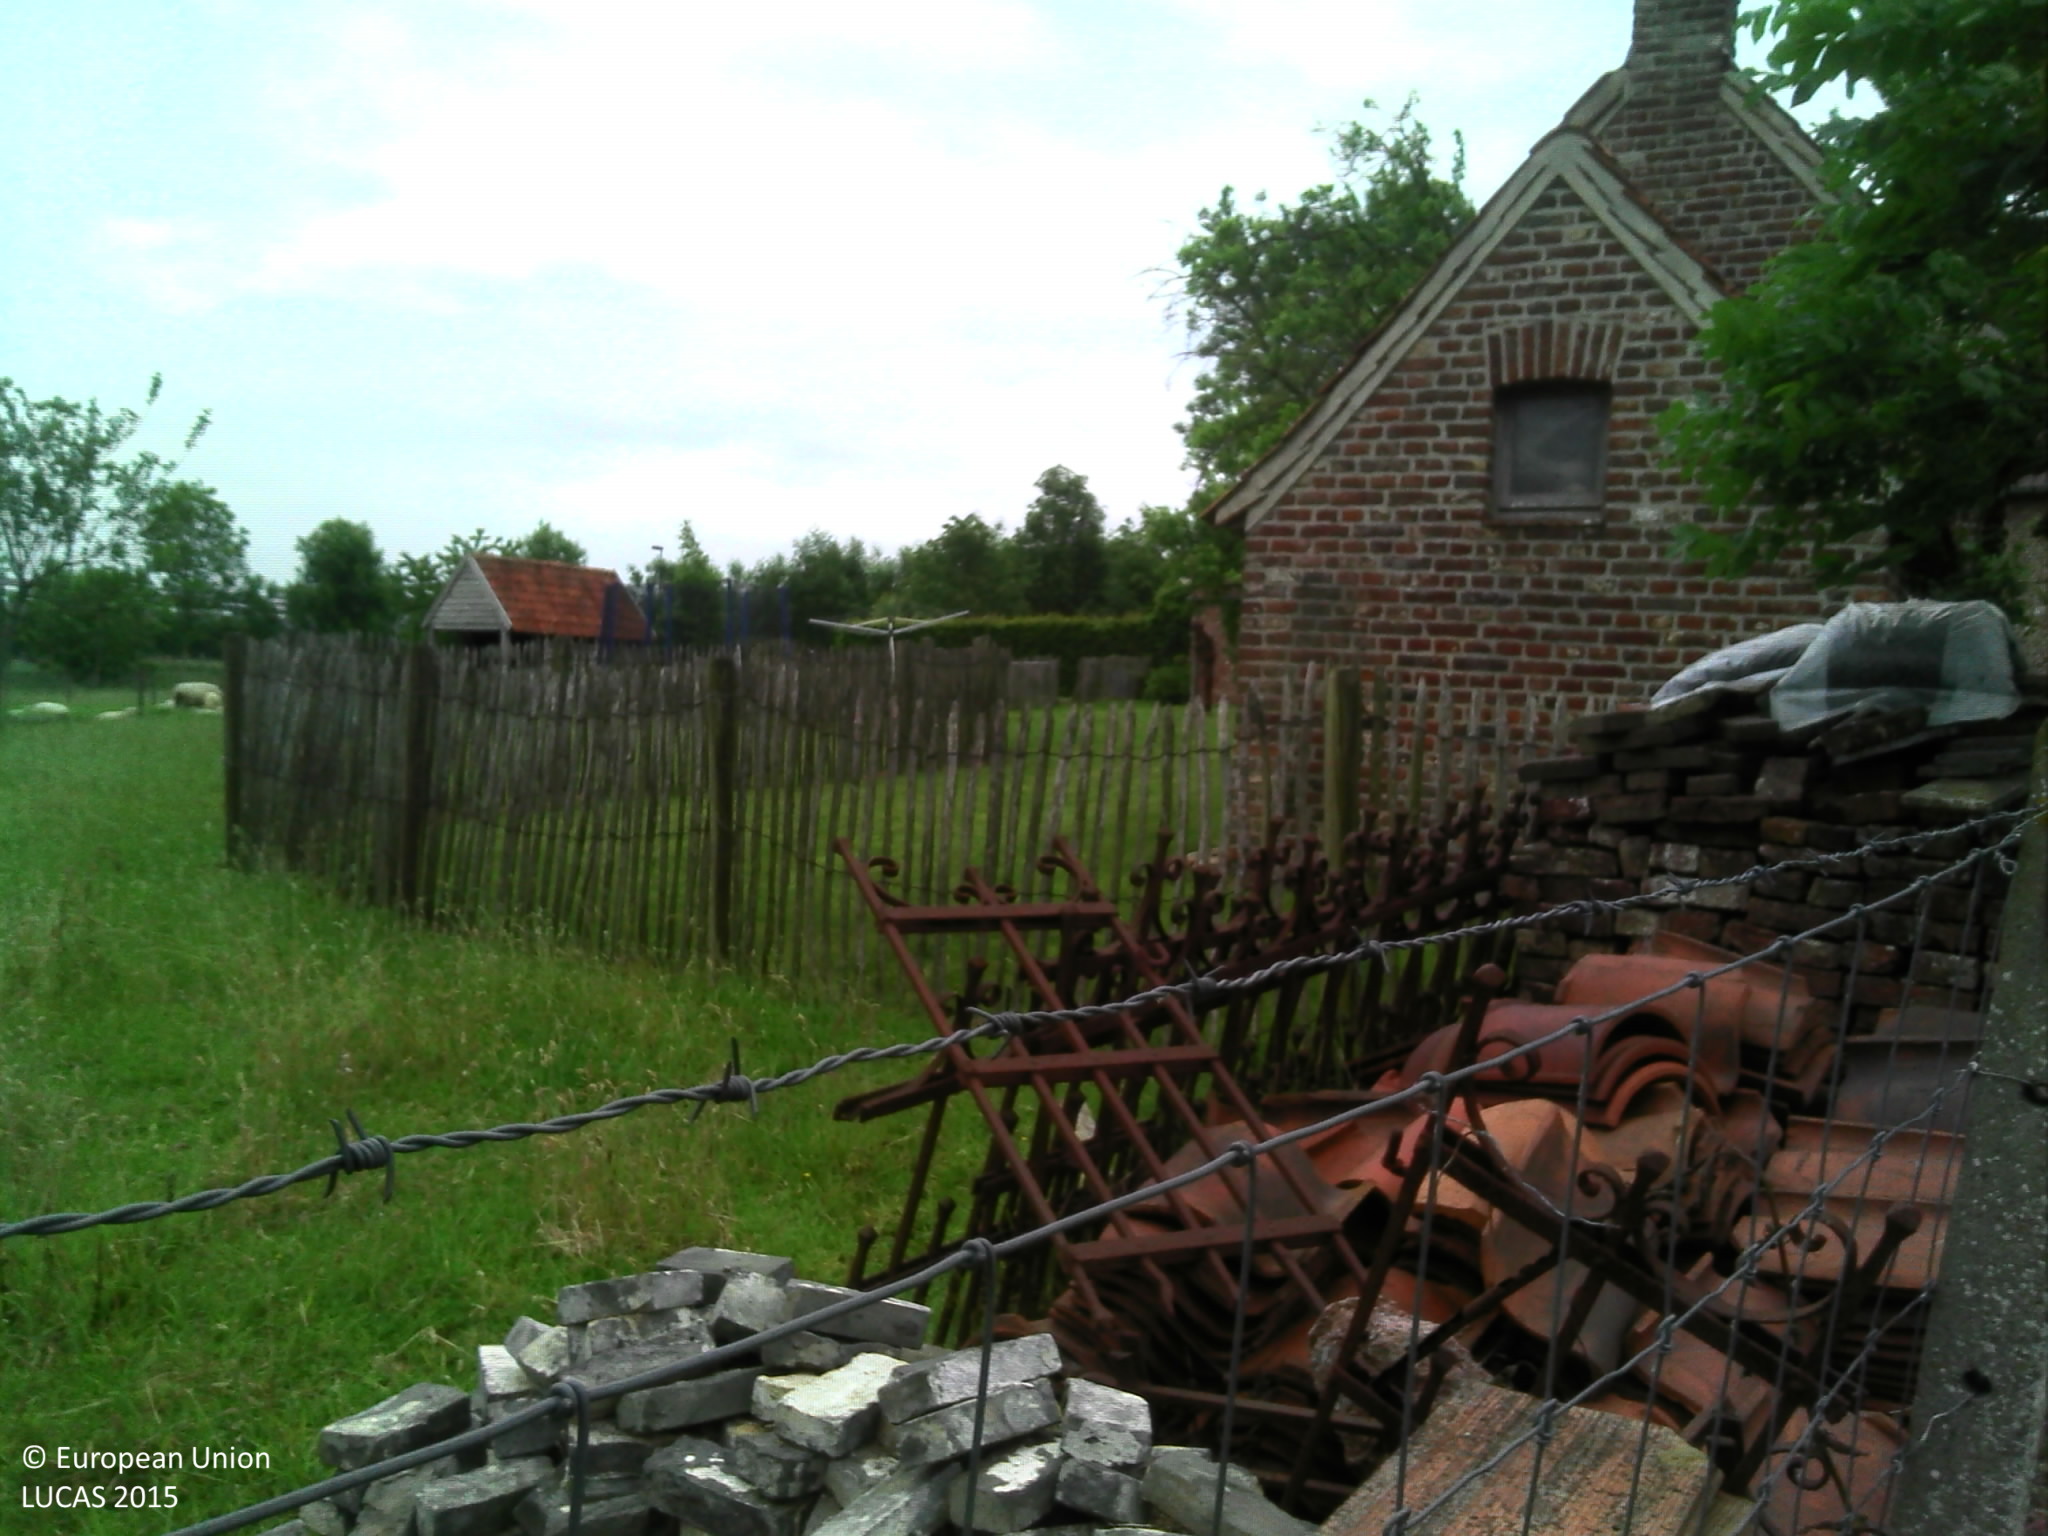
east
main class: Grassland
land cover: Grassland without tree/shrub cover
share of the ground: > 75 %
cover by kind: herbaceous plants 100 %
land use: Residential
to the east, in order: Grassland without tree/shrub cover; Artificial constructions in urban areas; Grassland with sparse tree/shrub cover; Artificial constructions in urban areas; Ditches and canals; Maize; Artificial constructions in urban areas; Grassland without tree/shrub cover; Managed hedges; Electric lines; Grass margins; Paved roads, cycling and walking lanes; Grass margins; Maize; Artificial constructions in urban areas
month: June
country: BE
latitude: 50.8398
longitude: 3.7021
